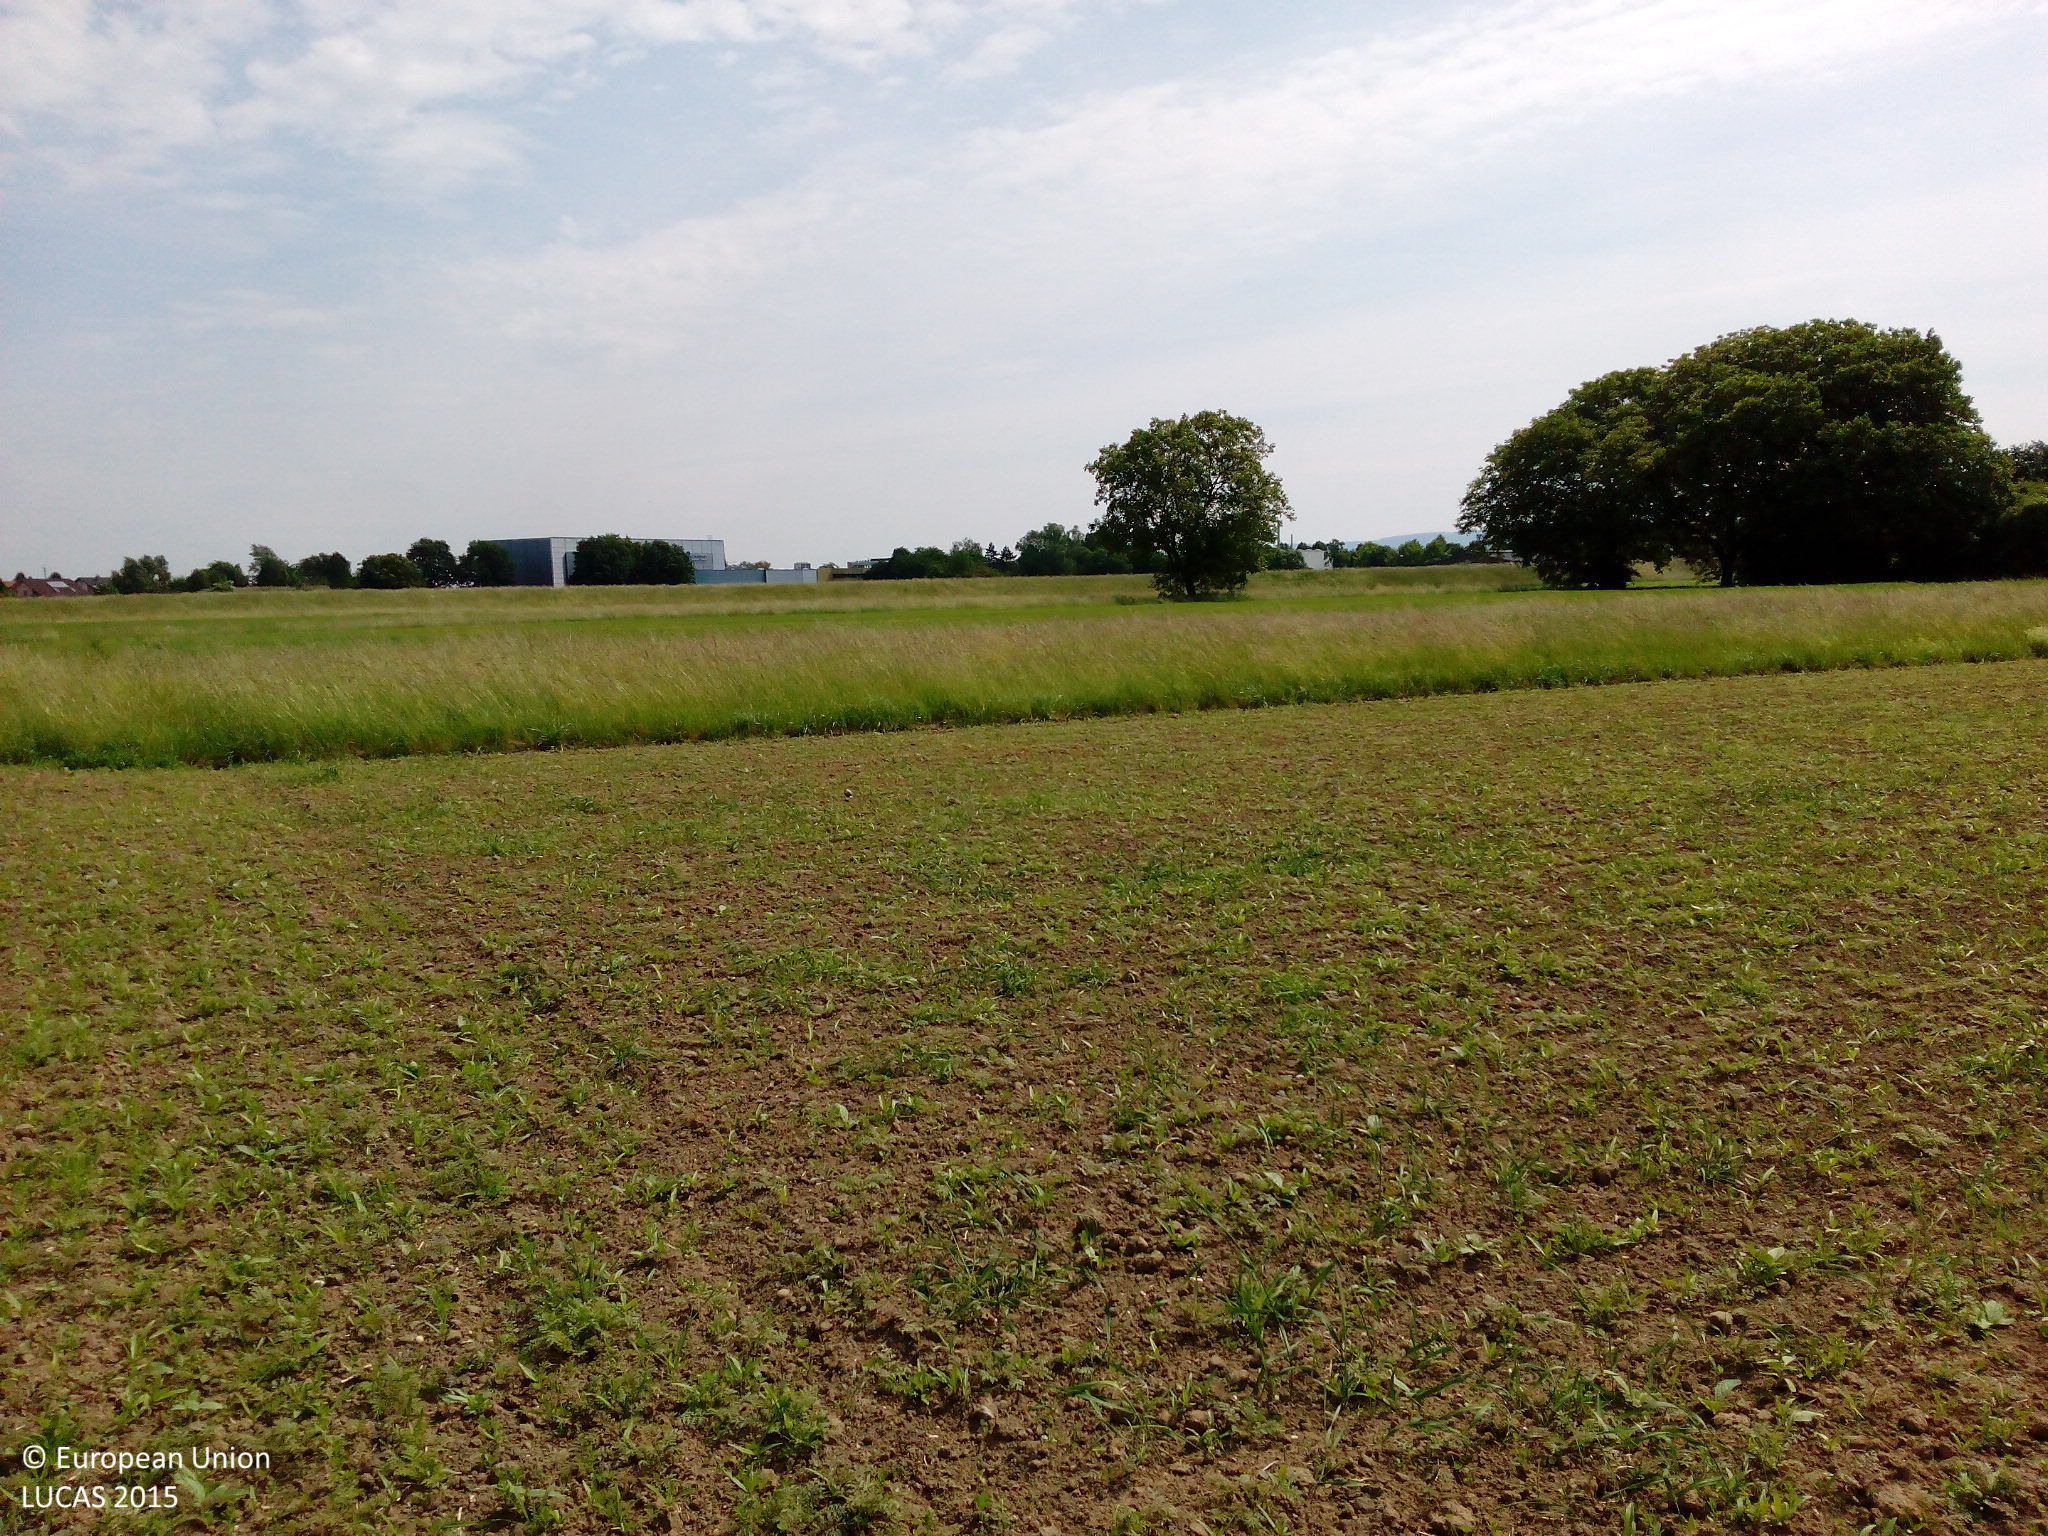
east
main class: Cropland
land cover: Other leguminous and mixtures for fodder
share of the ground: < 10 %
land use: Agriculture (excluding fallow land and kitchen gardens)
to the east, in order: Other leguminous and mixtures for fodder; Grassland without tree/shrub cover; Common wheat; Grassland without tree/shrub cover; Common wheat; Single bushes/trees; Common wheat; Grassland without tree/shrub cover
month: May
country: DE
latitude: 48.8925
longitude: 8.1866
